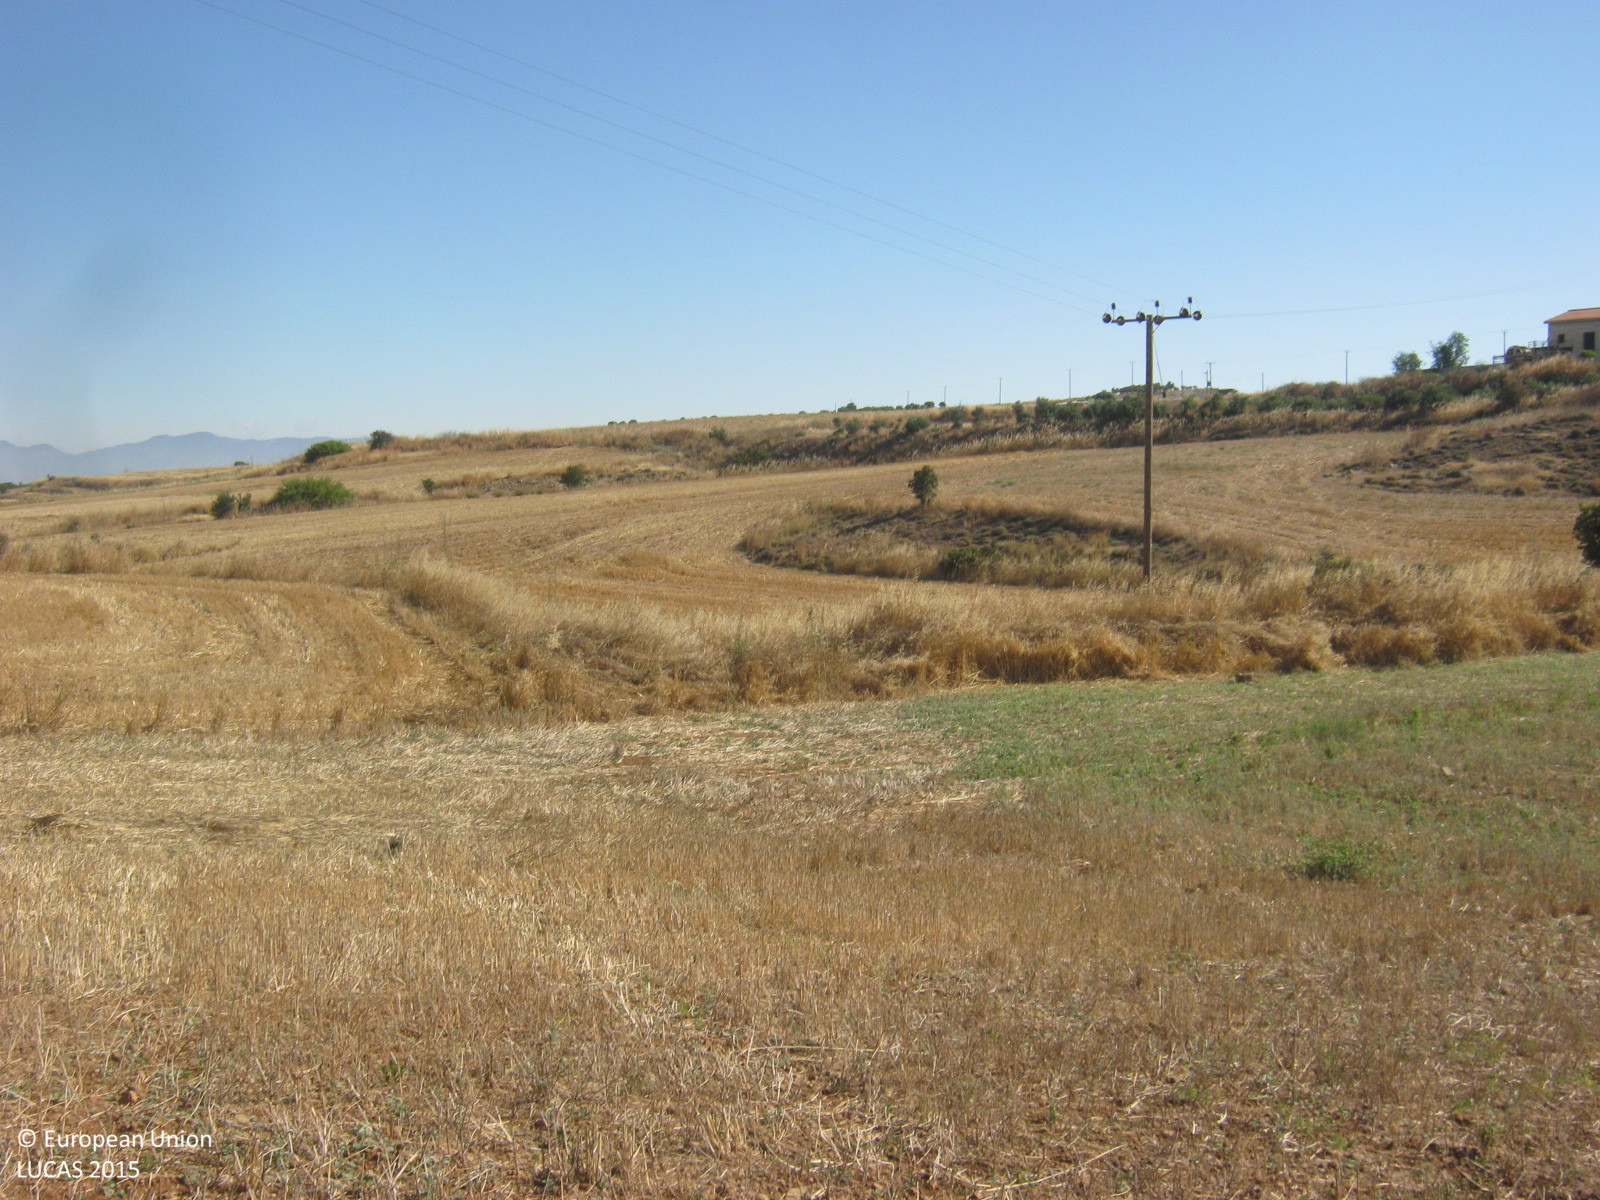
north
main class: Cropland
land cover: Barley
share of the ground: < 10 %
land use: Agriculture (excluding fallow land and kitchen gardens)
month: June
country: CY
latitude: 35.0844
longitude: 33.1839
